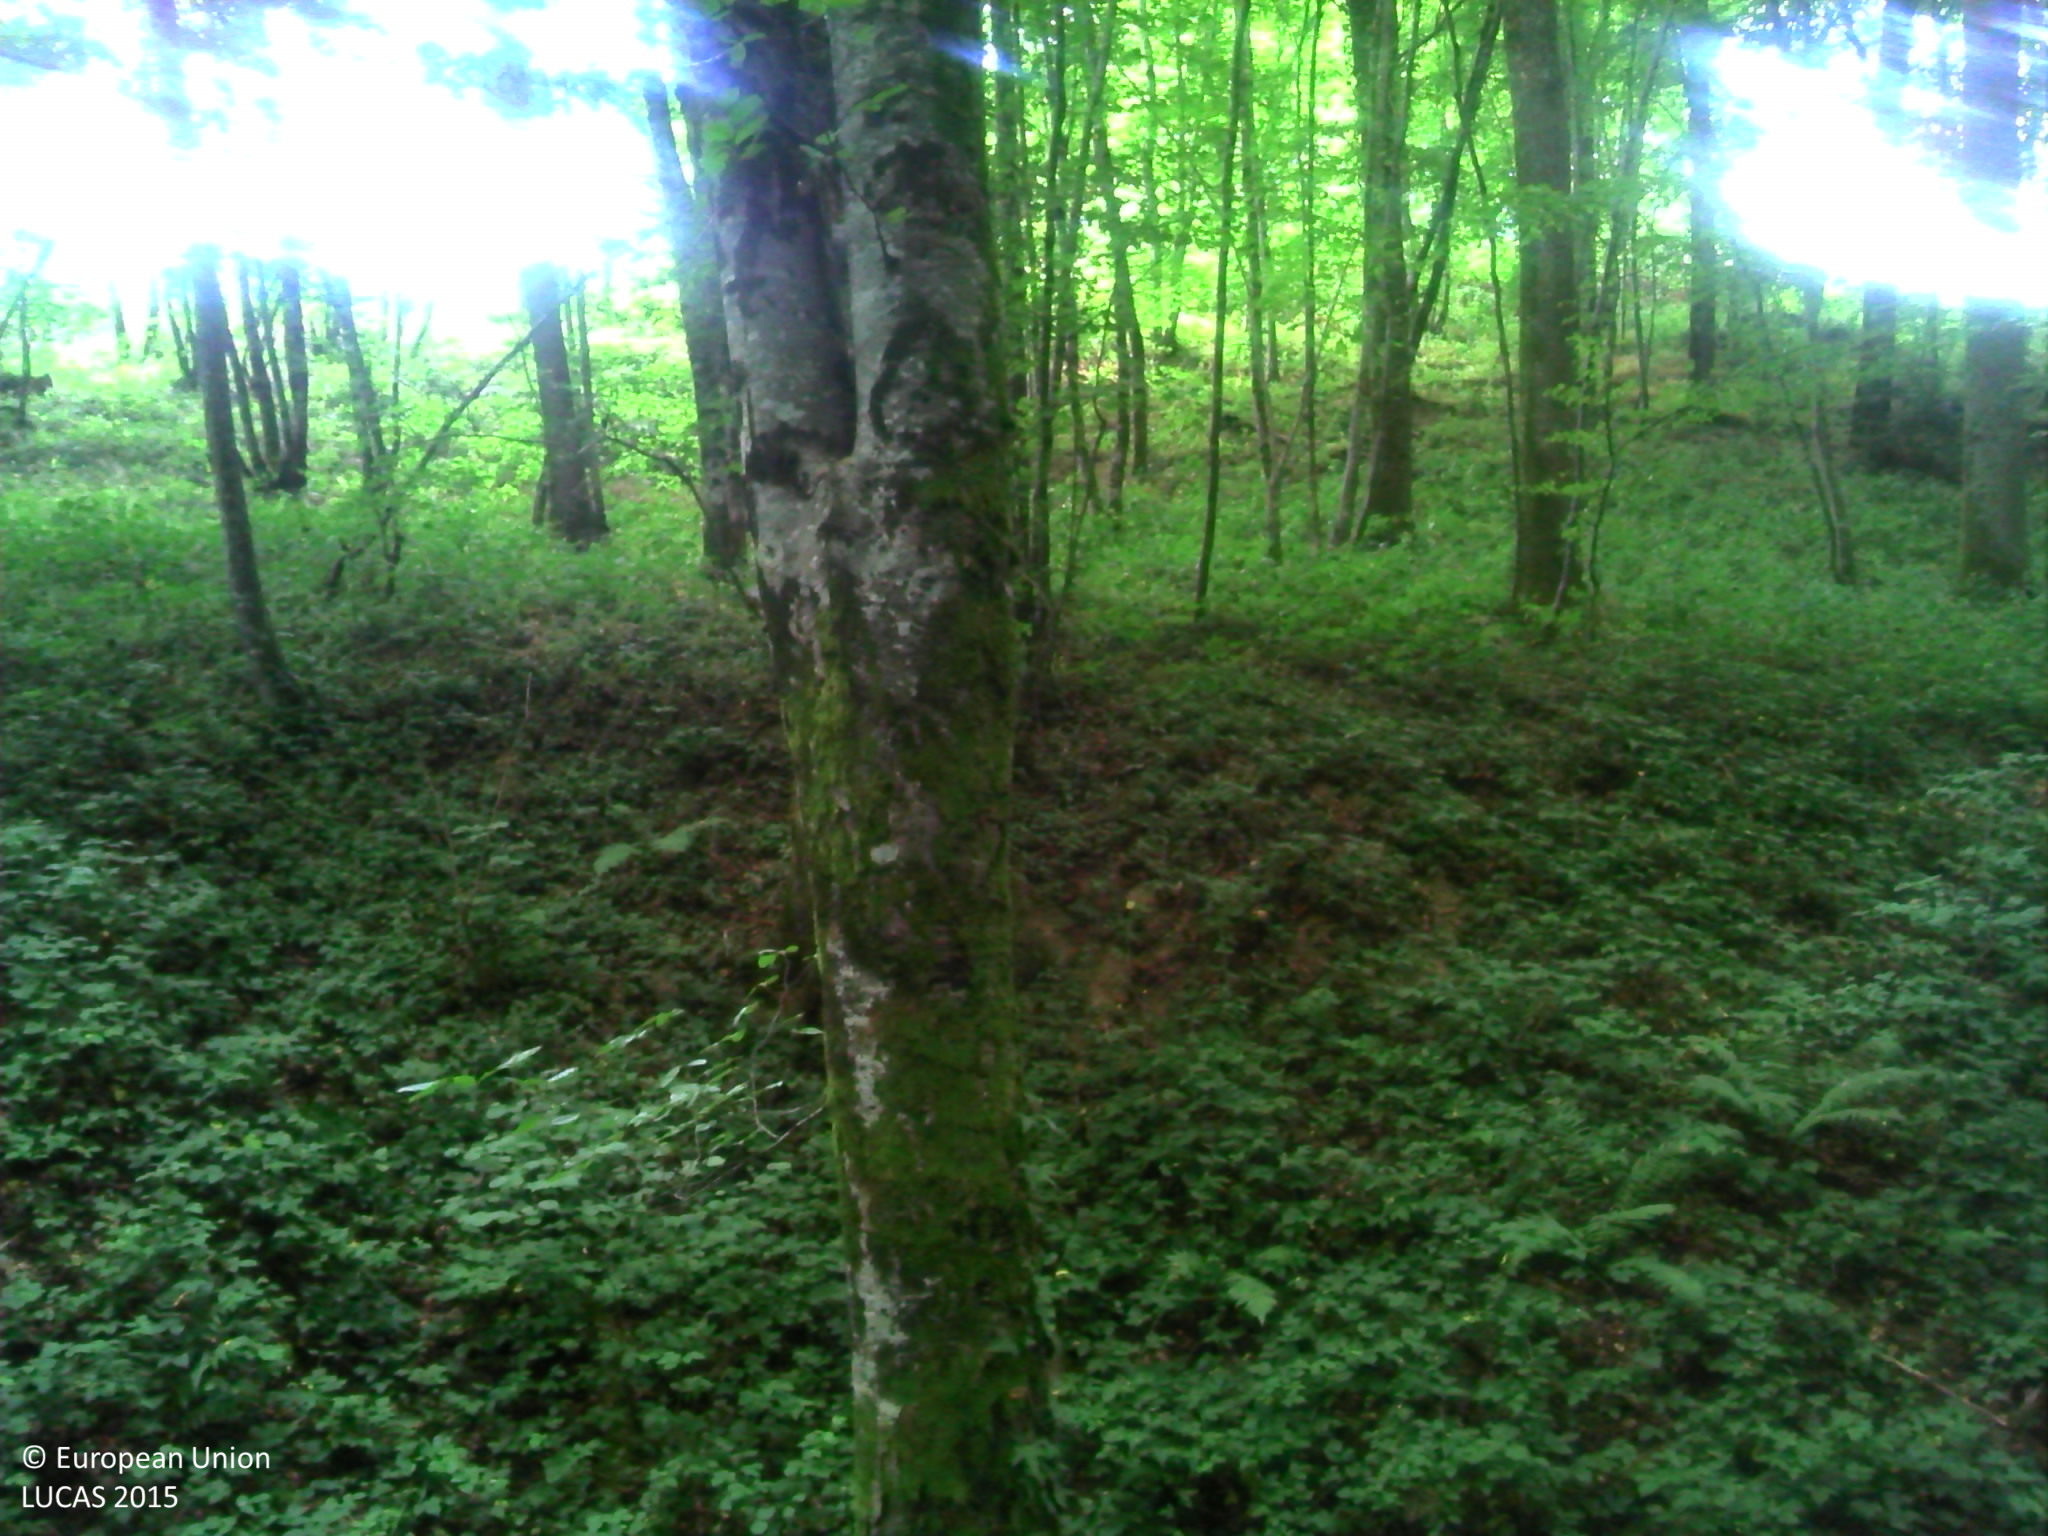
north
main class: Woodland
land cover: Broadleaved woodland
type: mesophytic deciduous forest
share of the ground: > 75 %
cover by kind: broadleaved forest trees 85 %, herbaceous plants 10 %, shrubs 5 %
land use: Forestry
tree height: > 5 m
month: July
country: FR
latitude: 46.3730
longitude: 1.7104
